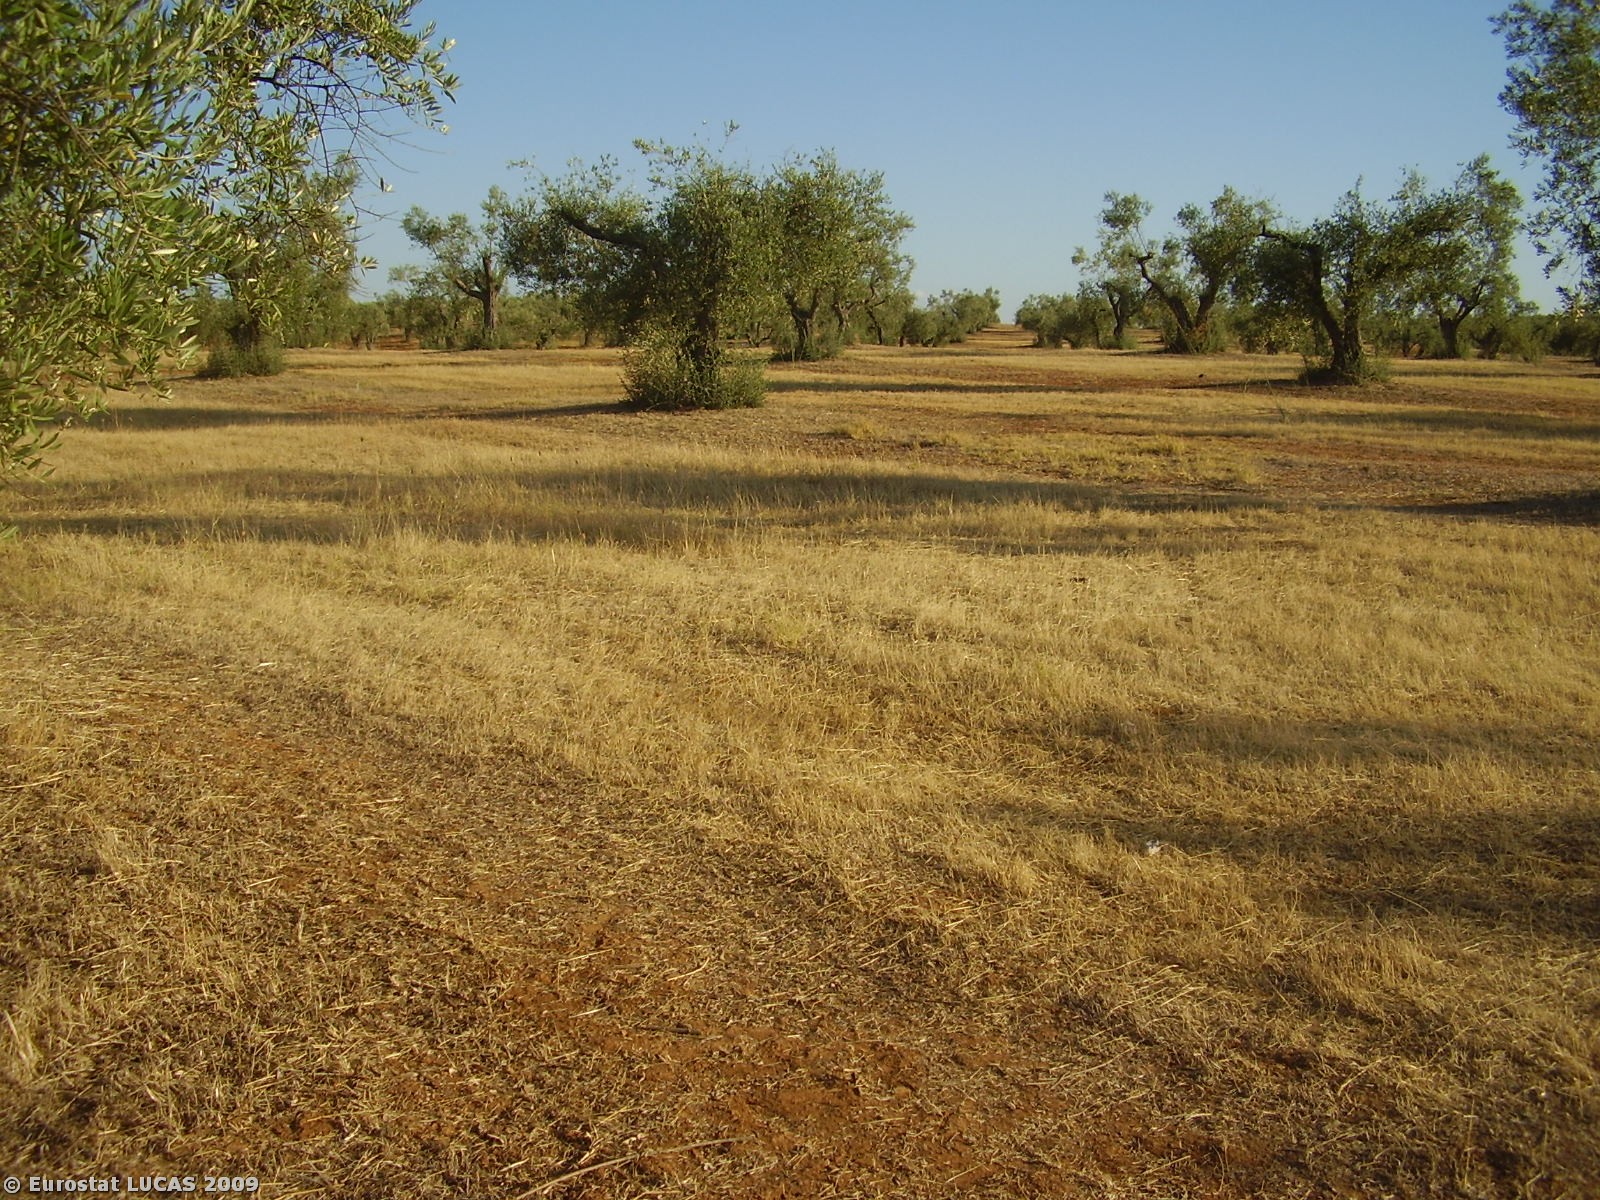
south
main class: Cropland
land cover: Olive groves
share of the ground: 10 - 25 %
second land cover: Mixed cereals for fodder
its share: > 75 %
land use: Agriculture (excluding fallow land and kitchen gardens)
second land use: Fallow land
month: August
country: PT
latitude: 38.0284
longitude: -7.5304
